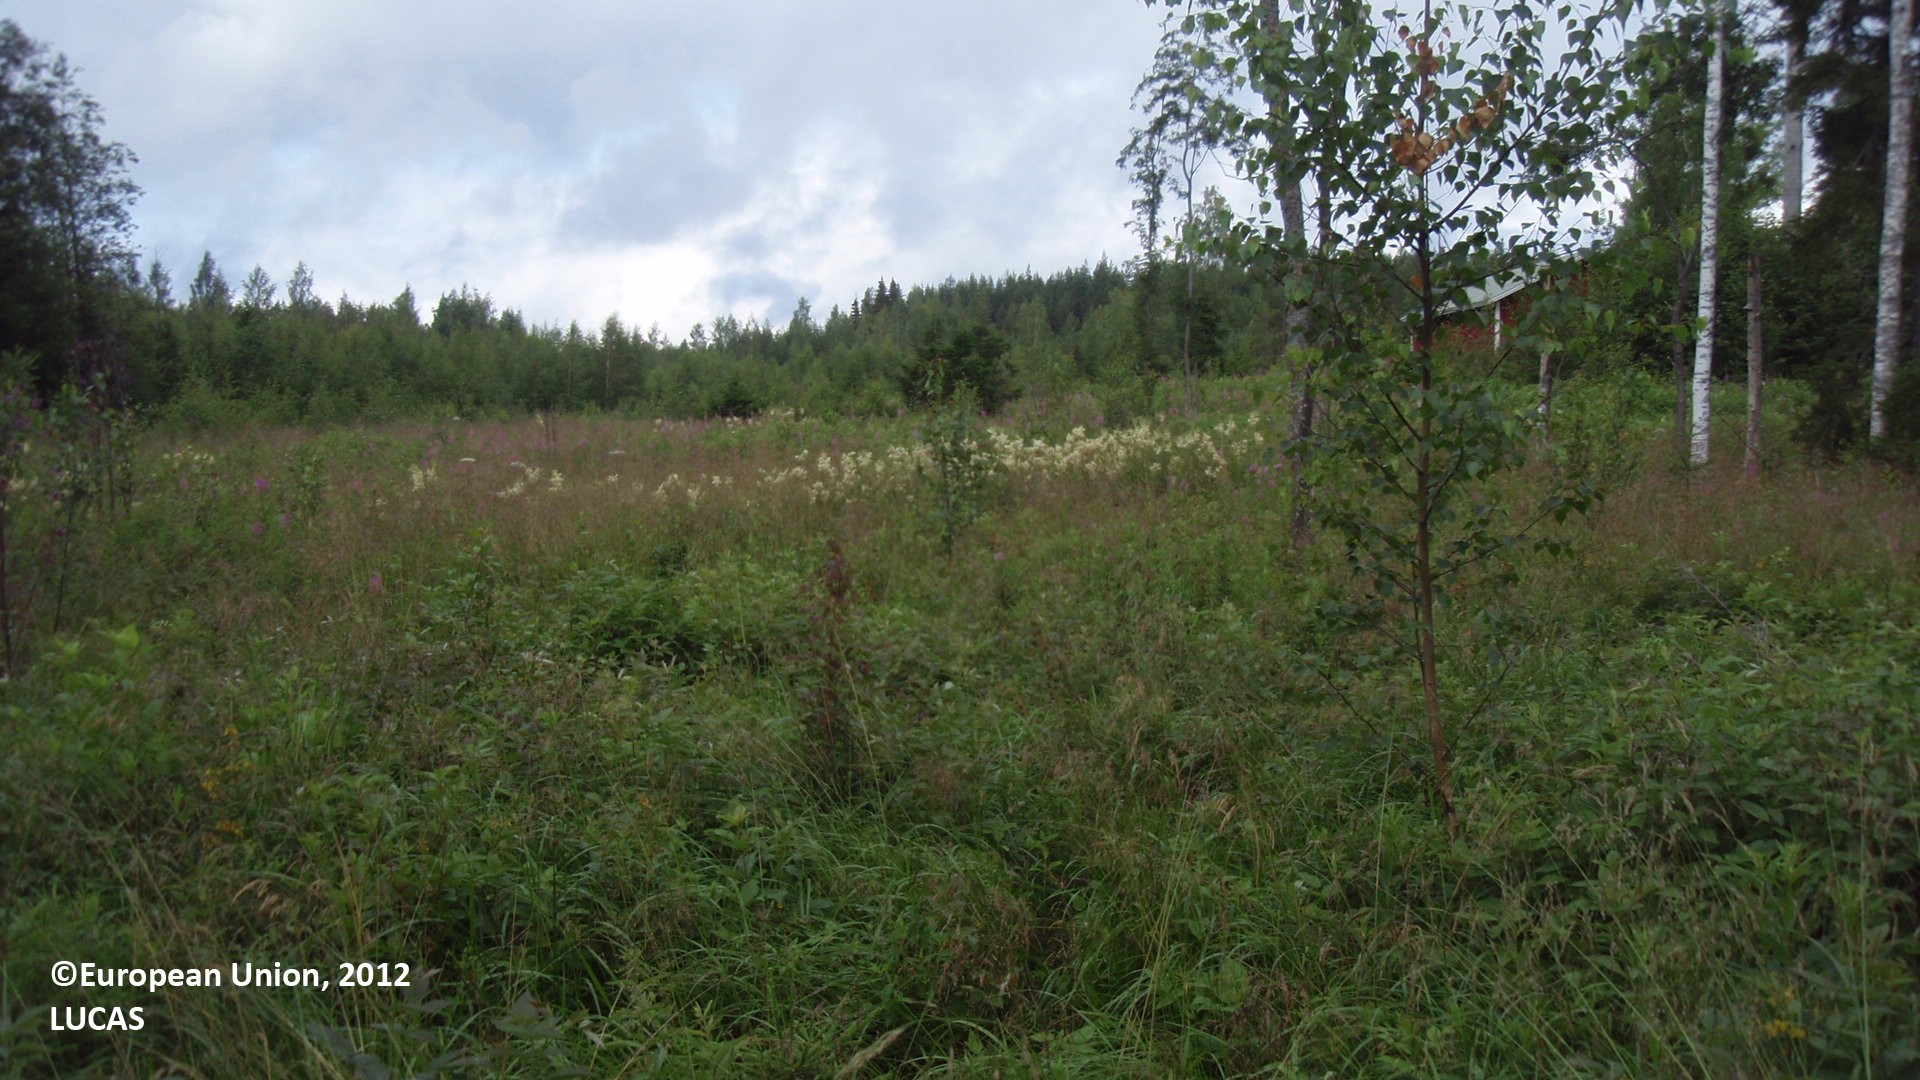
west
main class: Shrubland
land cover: Shrubland with sparse tree cover
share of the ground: > 75 %
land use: Fallow land
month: July
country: FI
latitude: 61.1521
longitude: 28.6327
